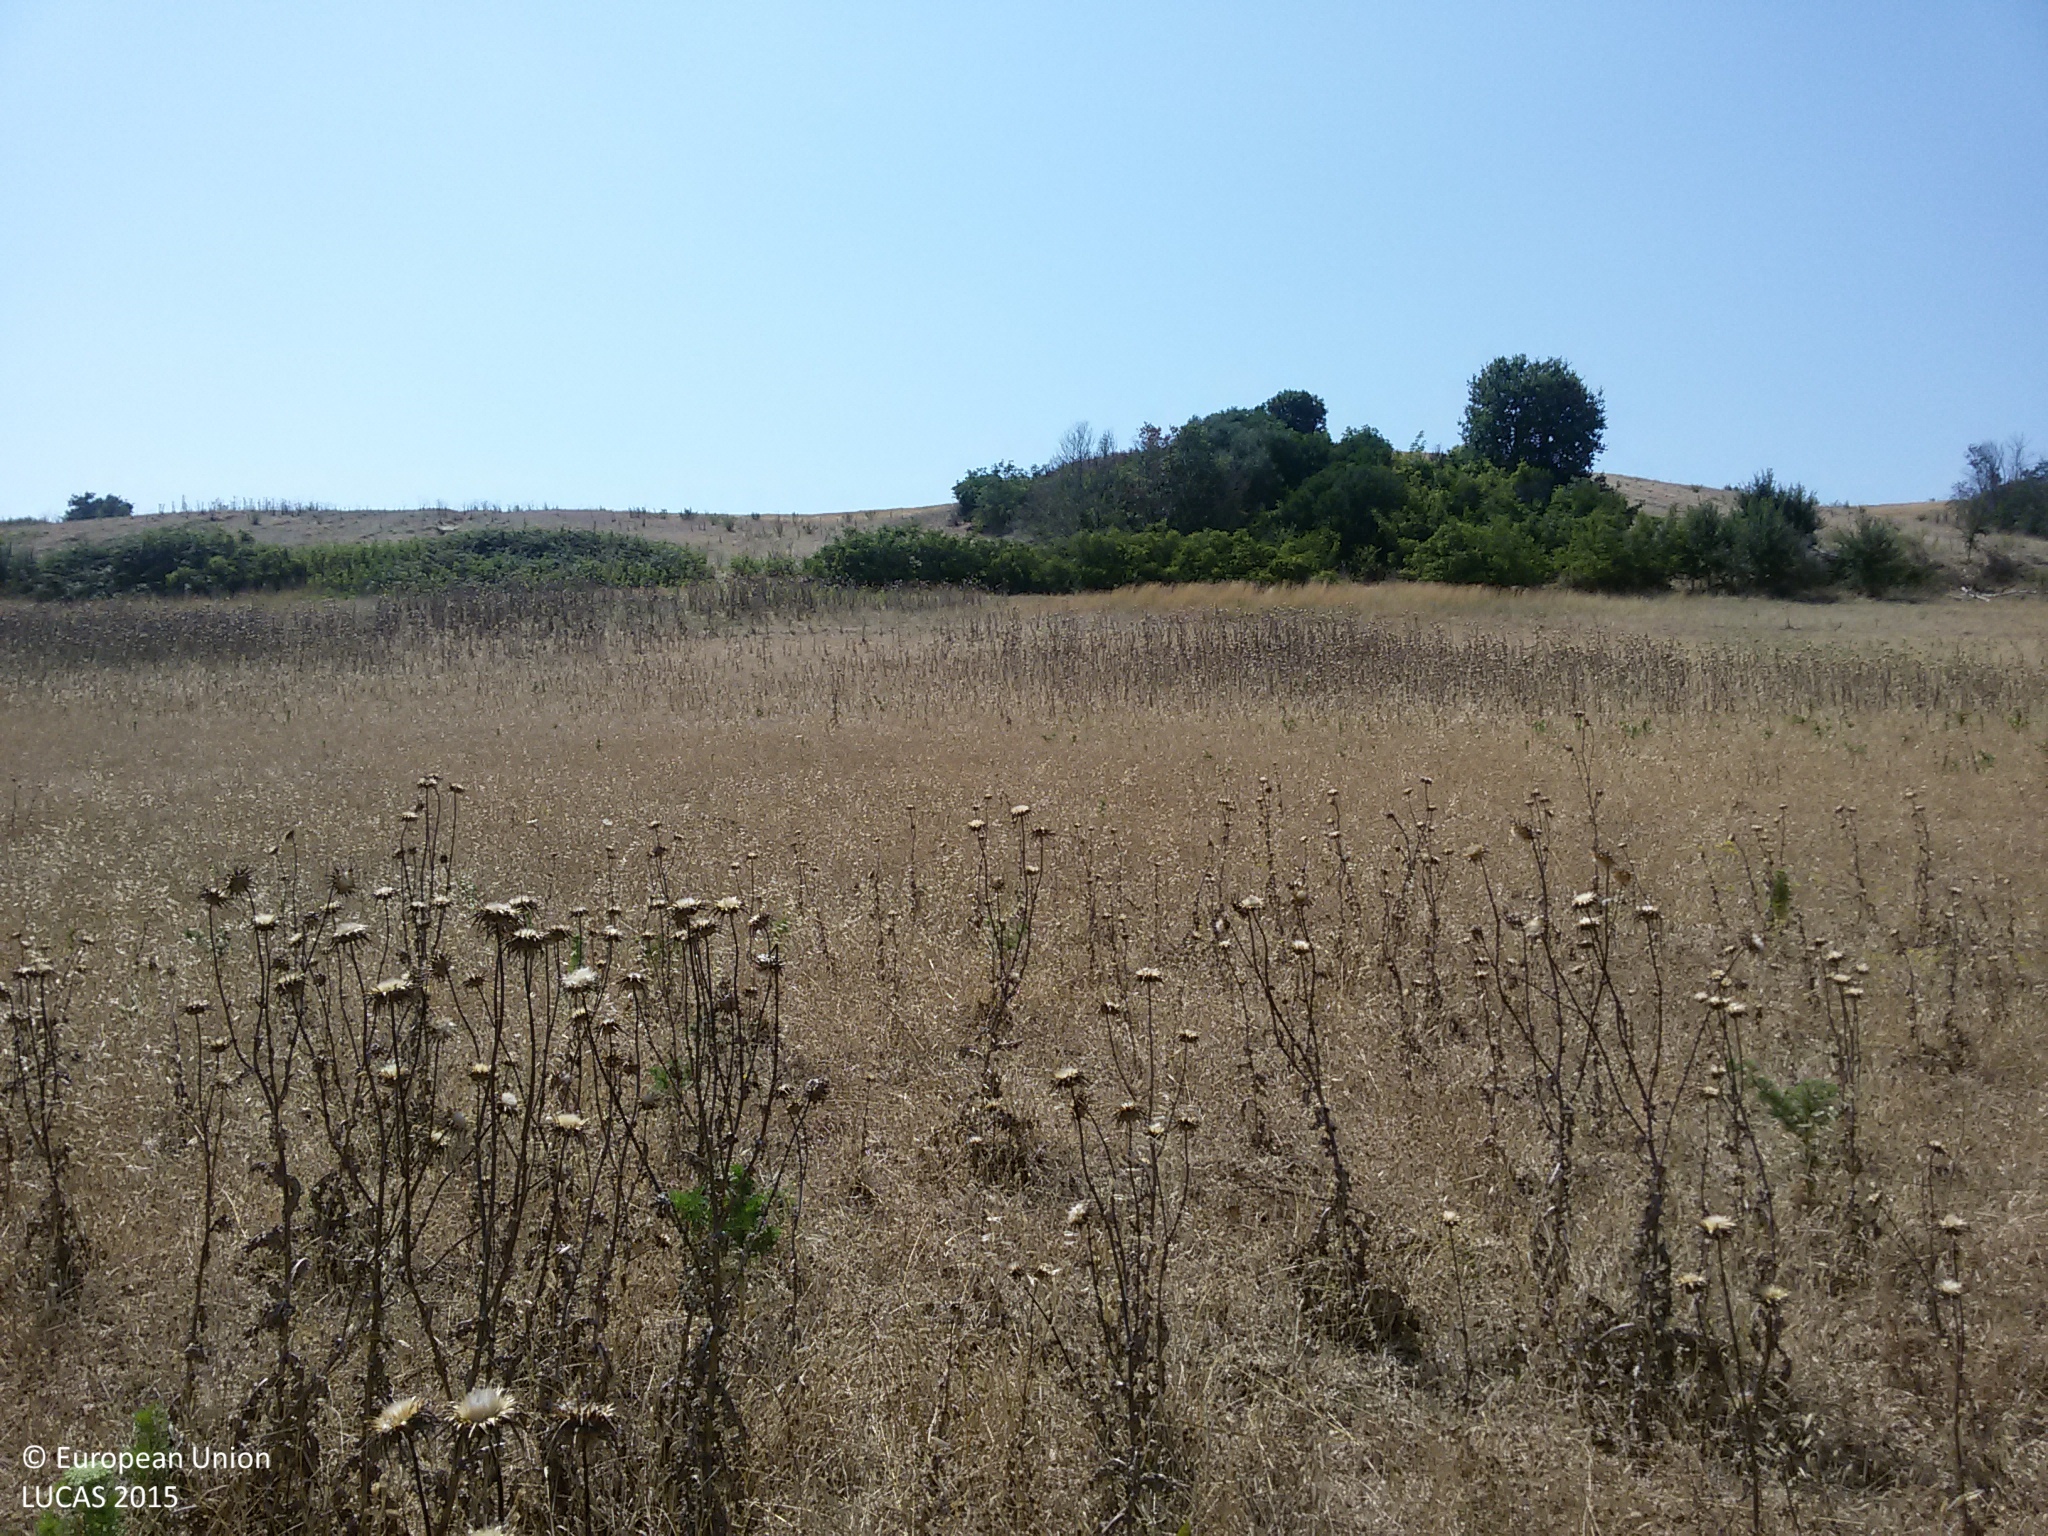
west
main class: Grassland
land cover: Grassland without tree/shrub cover
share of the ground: > 75 %
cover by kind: herbaceous plants 90 %, consolidated bare surface 5 %, unconsolidated bare surface 5 %
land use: Agriculture (excluding fallow land and kitchen gardens)
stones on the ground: 25 - 50 %
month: July
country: IT
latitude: 42.4605
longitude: 11.6118
